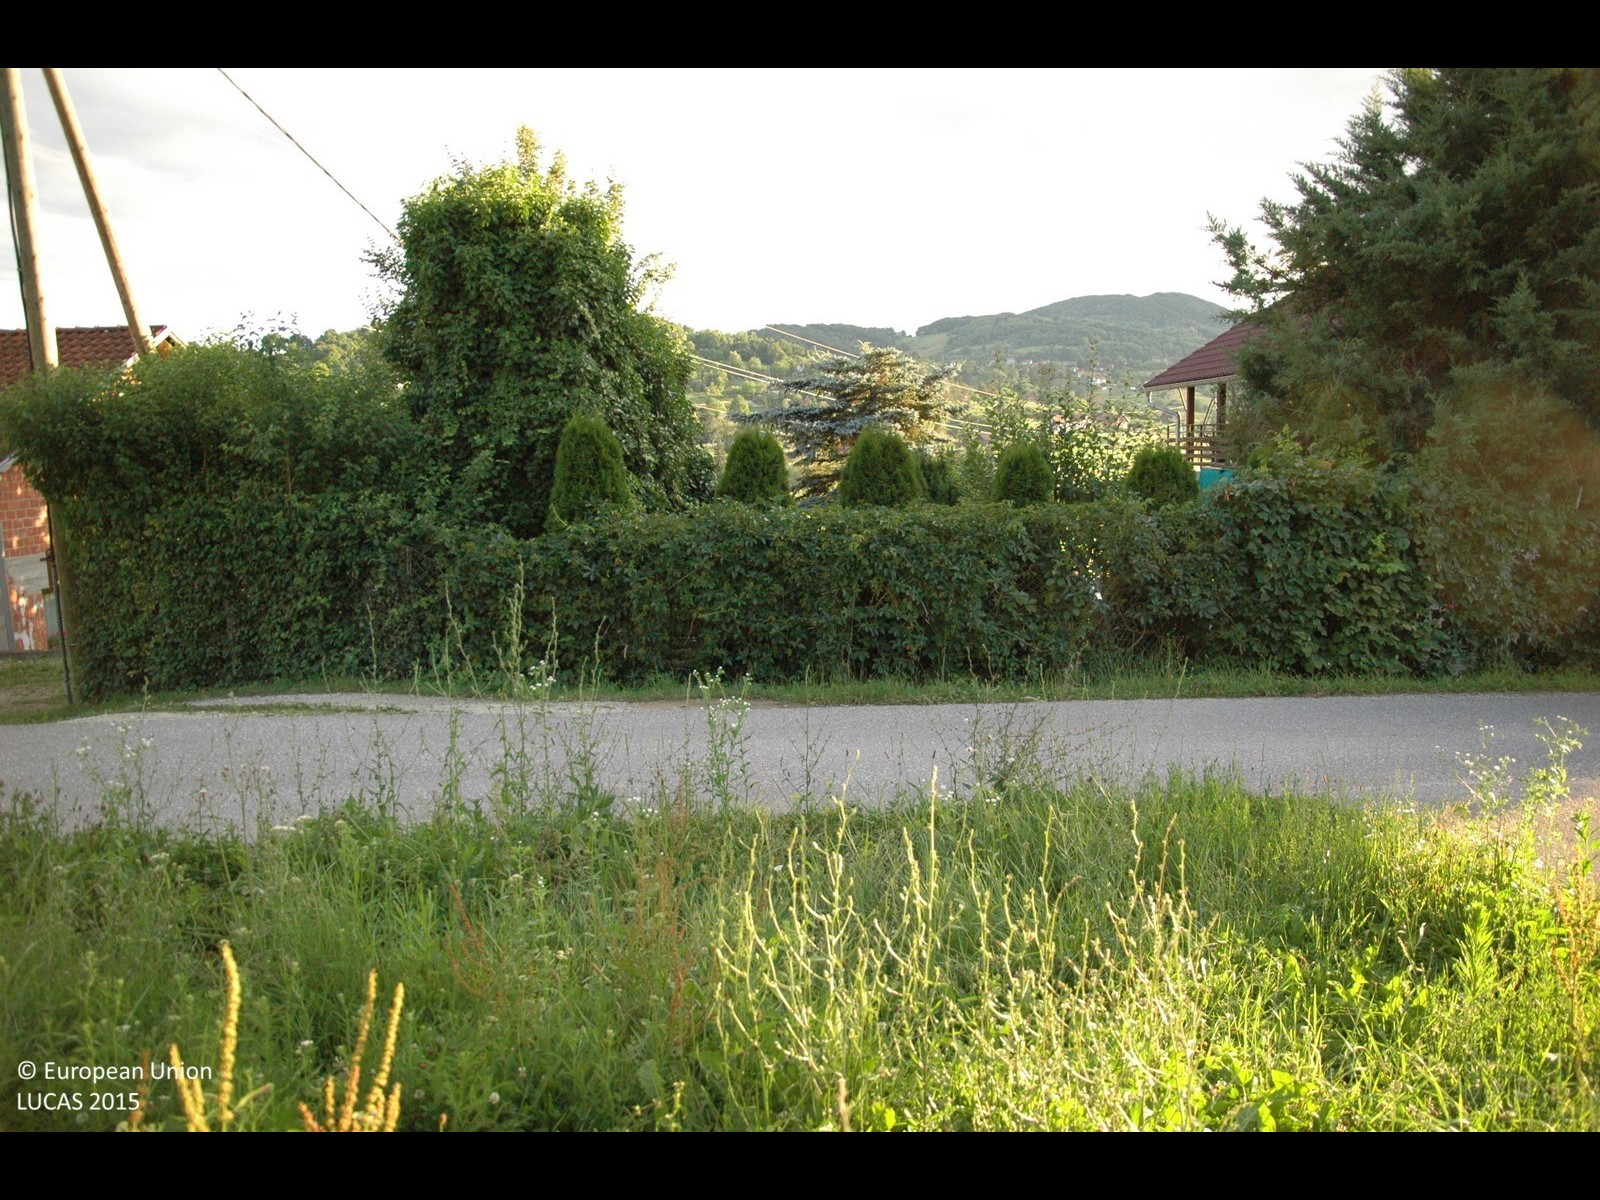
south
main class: Grassland
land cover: Grassland with sparse tree/shrub cover
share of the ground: > 75 %
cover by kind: herbaceous plants 95 %, broadleaved forest trees 5 %
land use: Residential
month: June
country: HR
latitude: 46.0687
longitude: 15.7772
